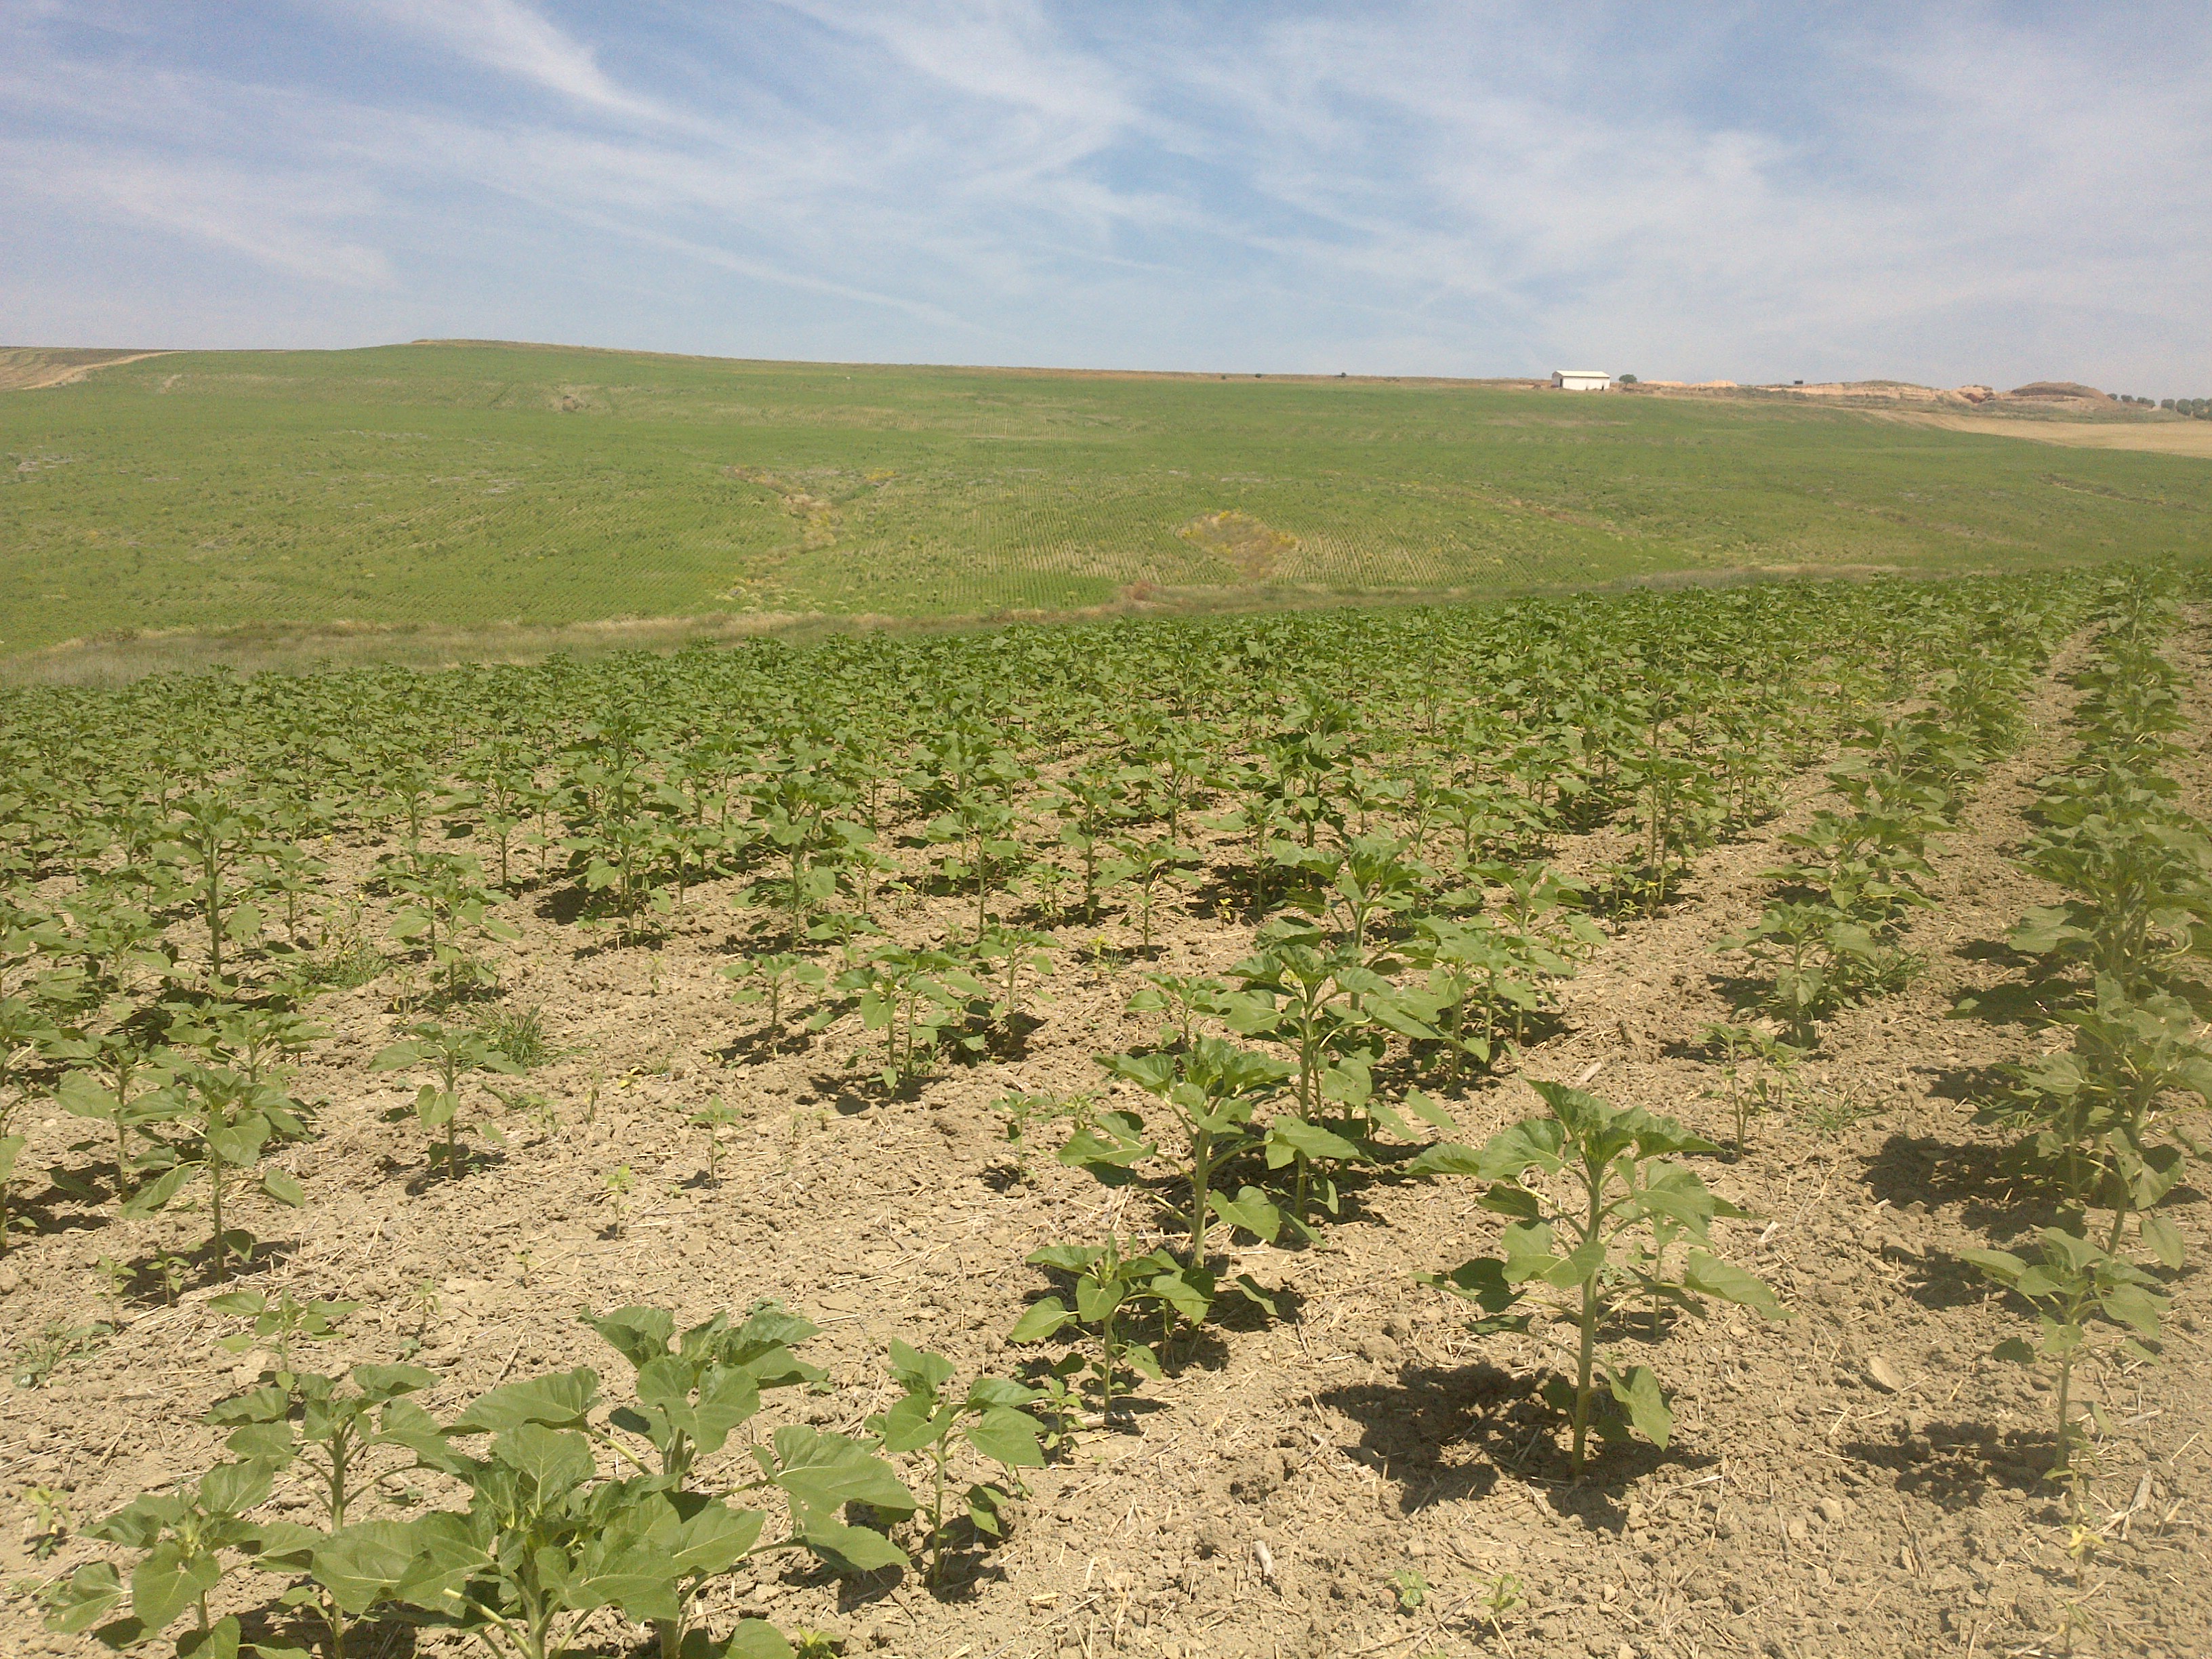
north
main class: Cropland
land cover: Sunflower
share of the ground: > 75 %
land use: Agriculture (excluding fallow land and kitchen gardens)
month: May
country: ES
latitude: 37.8548
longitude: -4.6625
